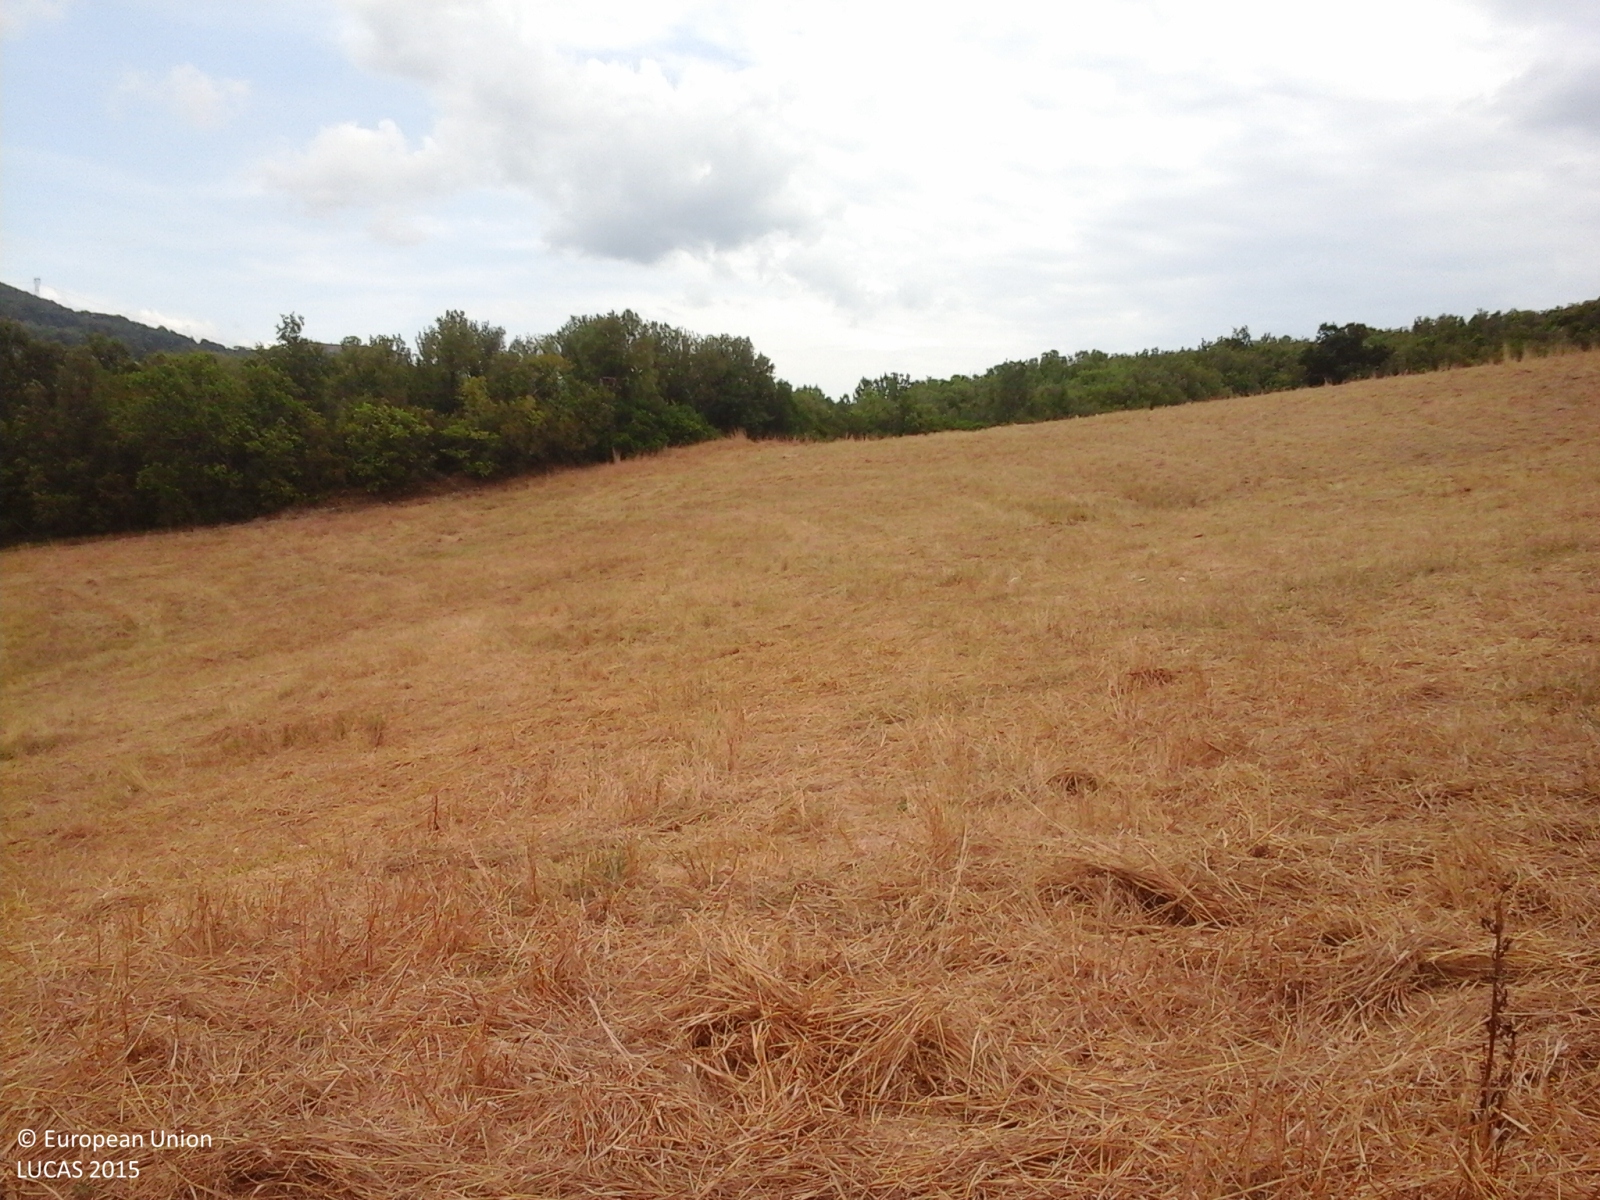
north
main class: Cropland
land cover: Durum wheat
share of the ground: > 75 %
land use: Agriculture (excluding fallow land and kitchen gardens)
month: August
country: IT
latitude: 43.2112
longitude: 10.7241
